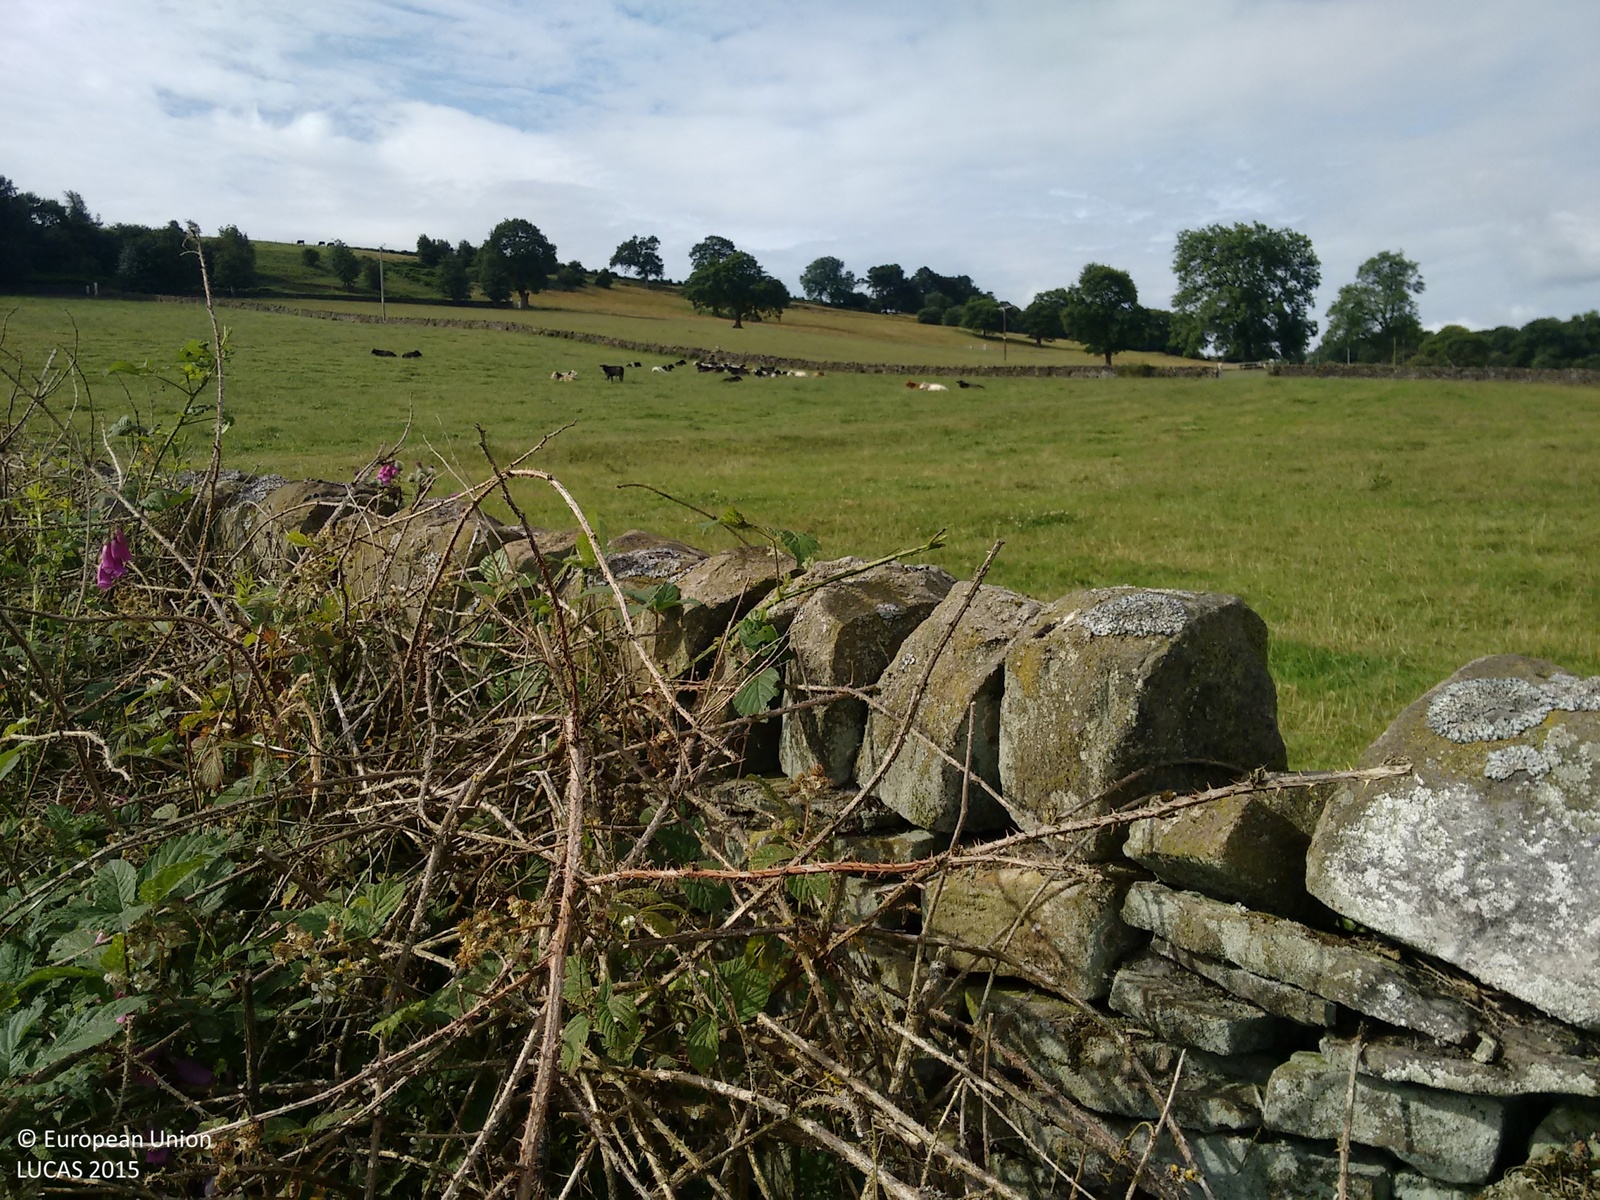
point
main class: Grassland
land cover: Grassland without tree/shrub cover
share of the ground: > 75 %
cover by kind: herbaceous plants 100 %
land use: Agriculture (excluding fallow land and kitchen gardens)
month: July
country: GB
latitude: 53.0851
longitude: -1.5321
